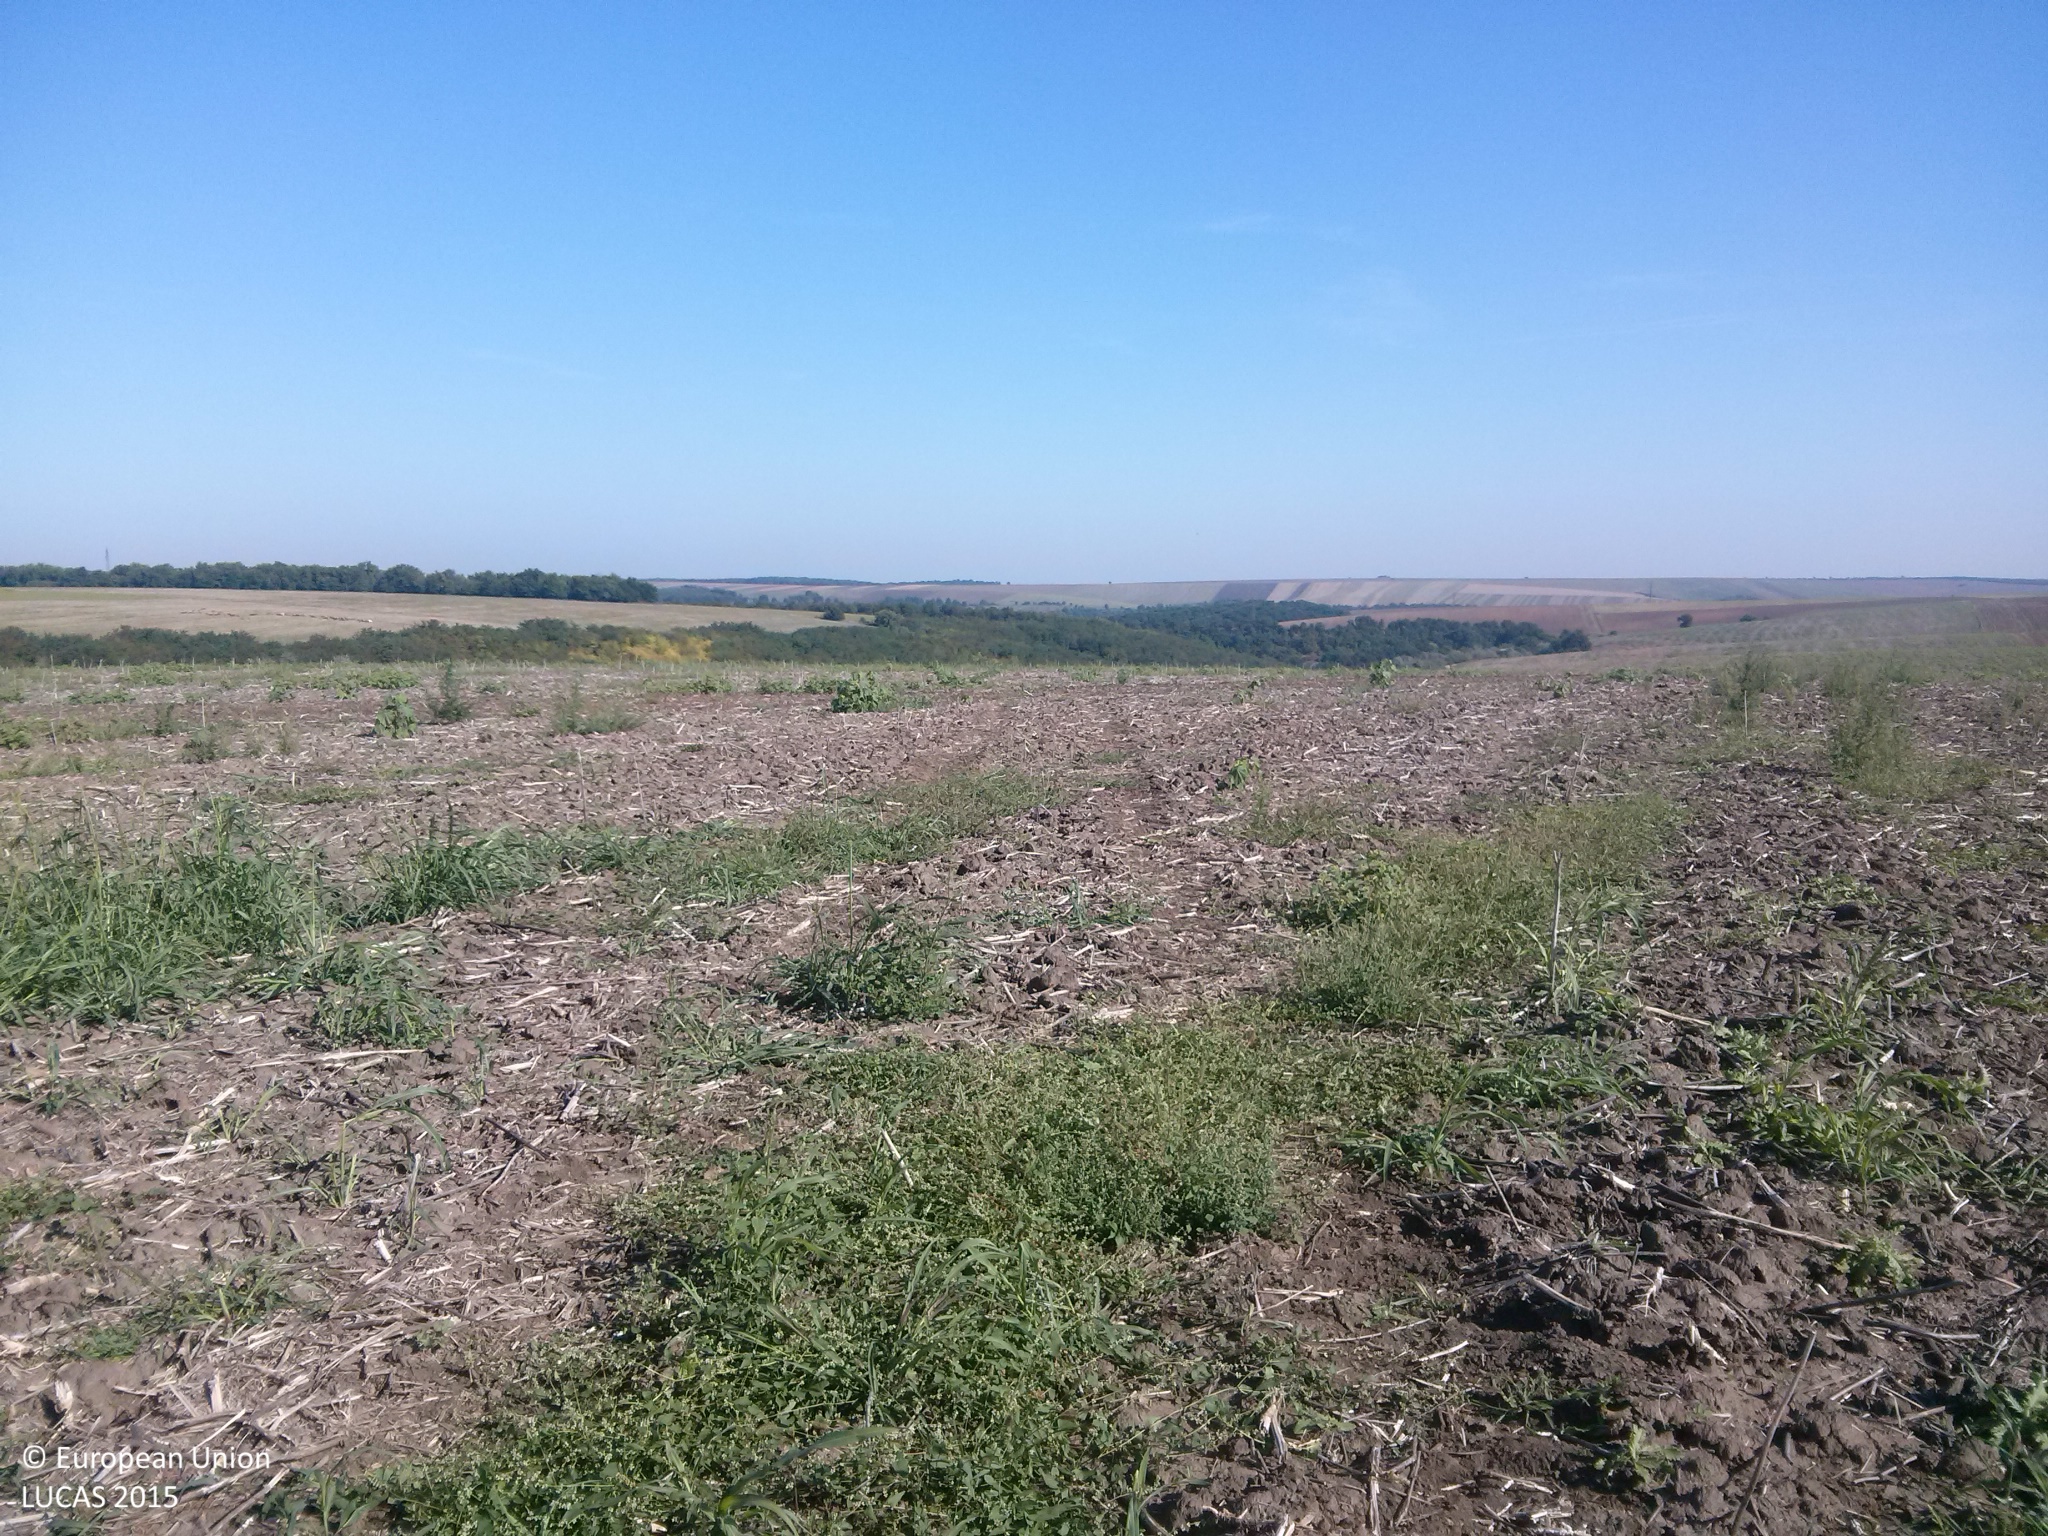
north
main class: Cropland
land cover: Rape and turnip rape
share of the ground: < 10 %
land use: Agriculture (excluding fallow land and kitchen gardens)
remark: Harvested field
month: September
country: BG
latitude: 43.7538
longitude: 26.3869
